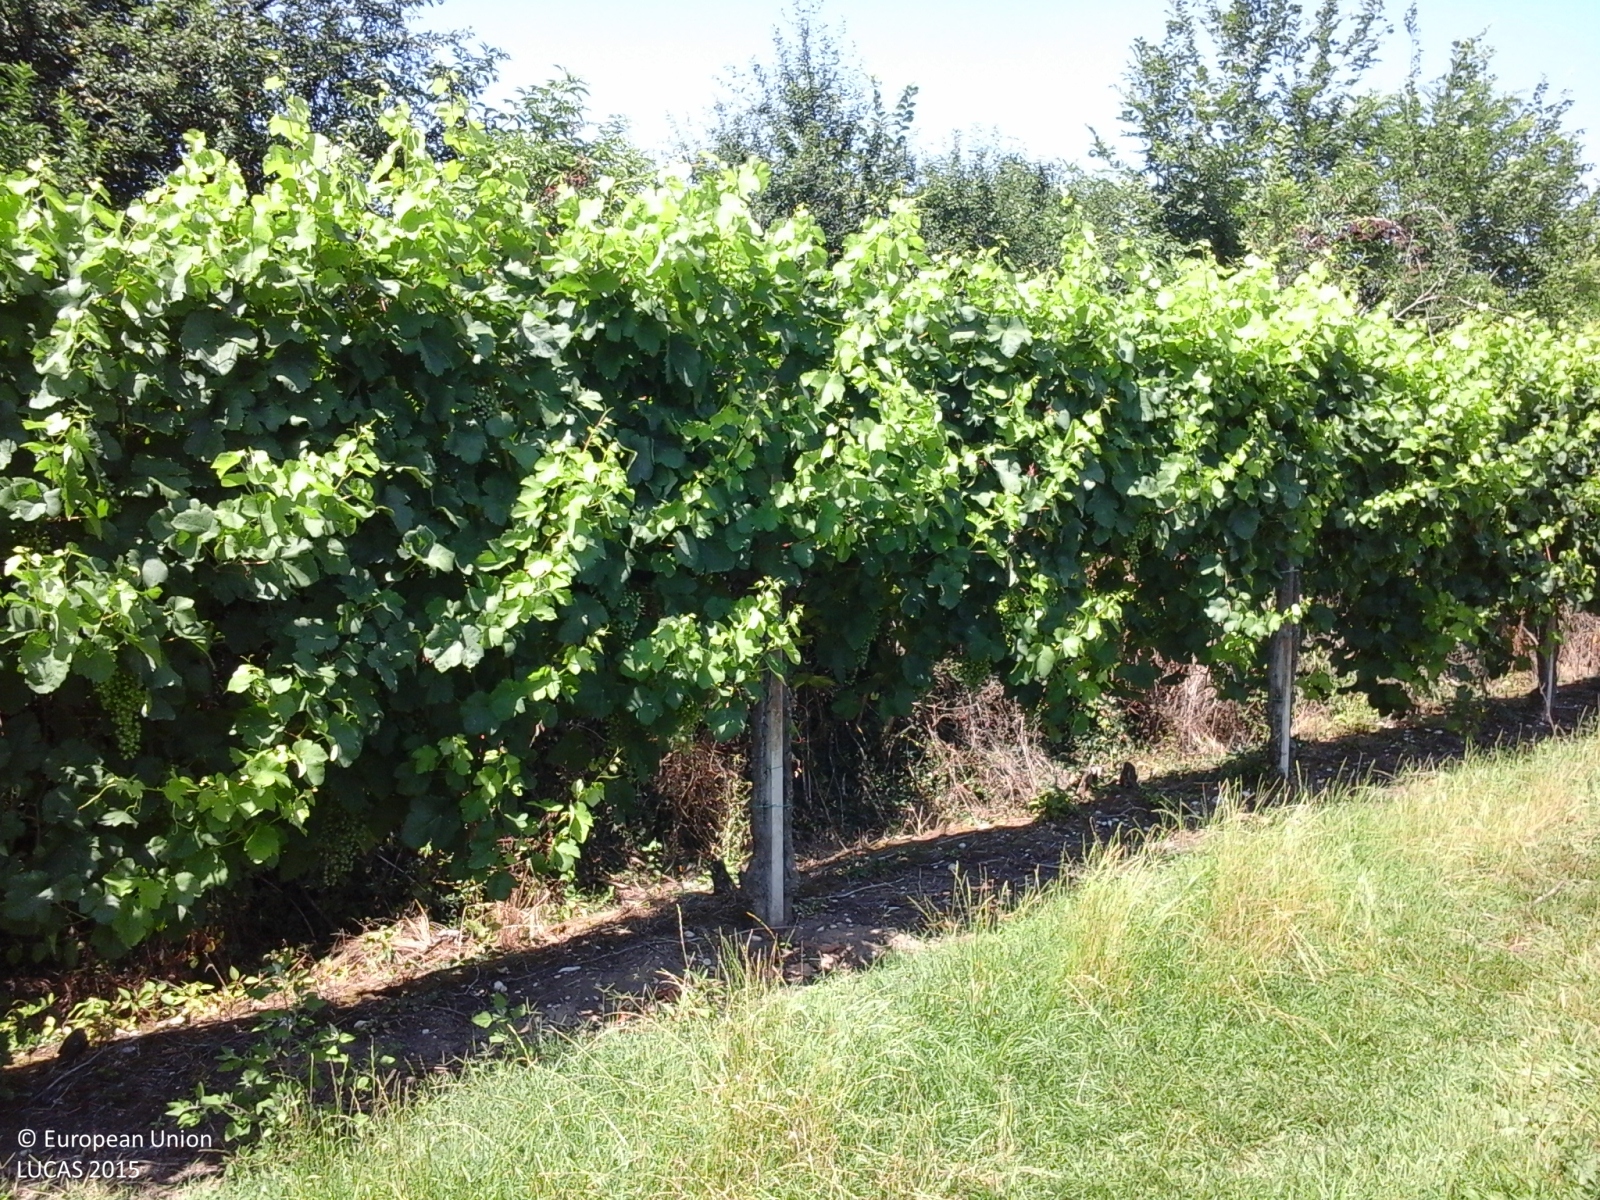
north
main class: Cropland
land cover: Vineyards
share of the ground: 25 - 50 %
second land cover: Grassland without tree/shrub cover
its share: > 75 %
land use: Agriculture (excluding fallow land and kitchen gardens)
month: July
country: IT
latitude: 45.8027
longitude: 12.3513
